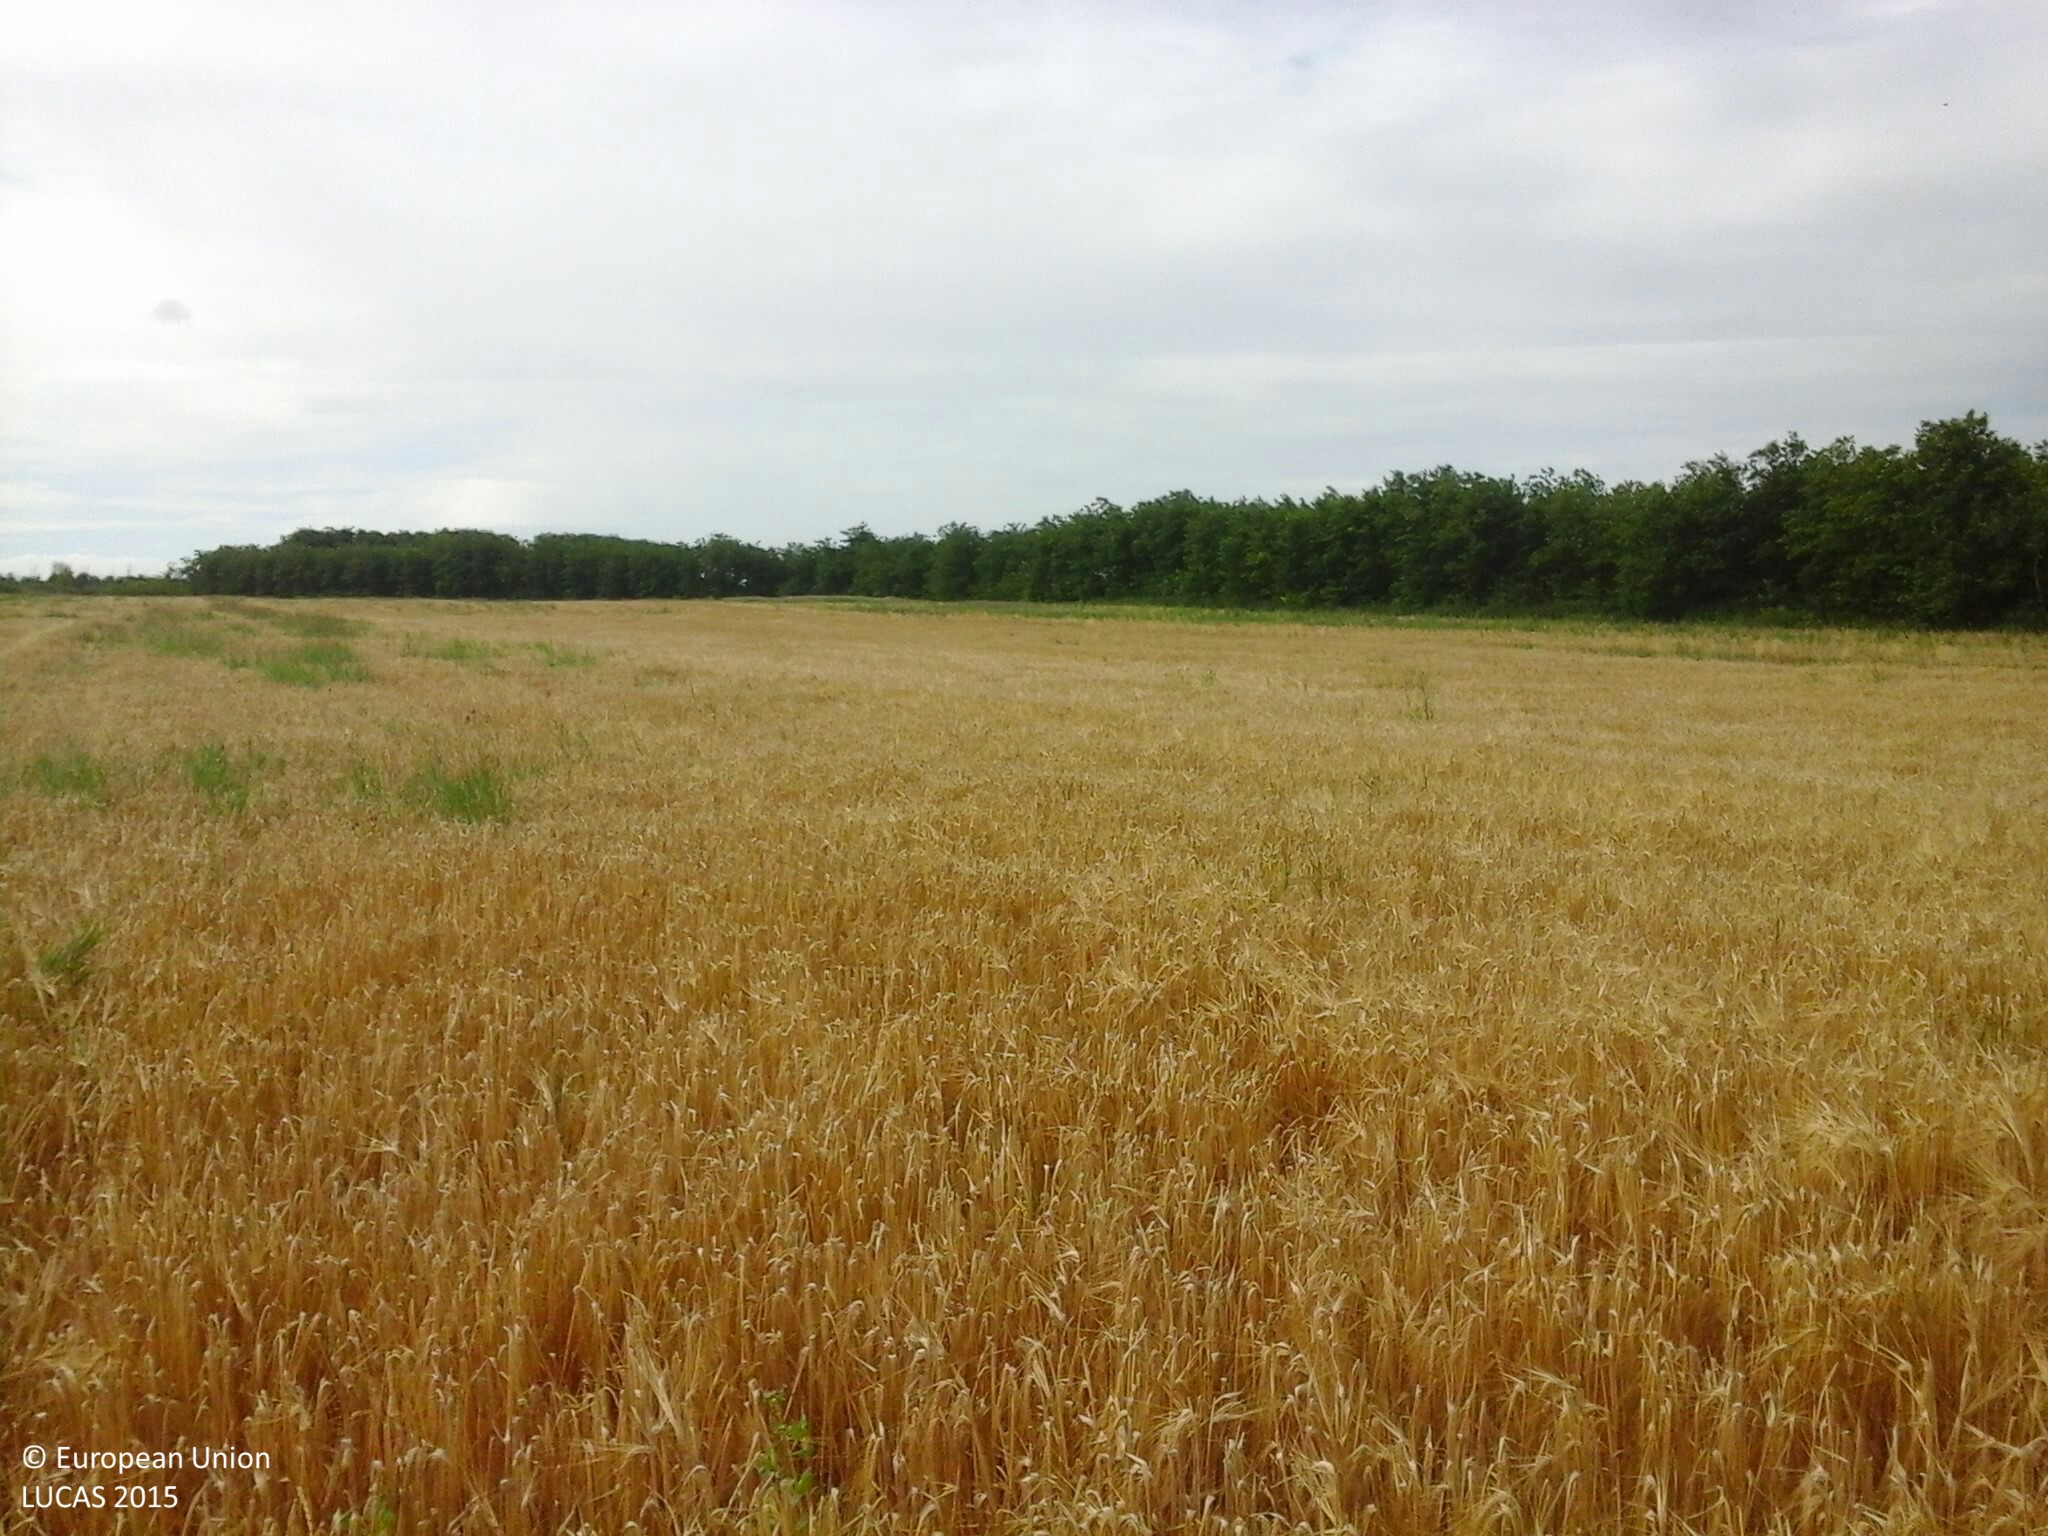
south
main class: Cropland
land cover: Barley
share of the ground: > 75 %
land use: Agriculture (excluding fallow land and kitchen gardens)
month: July
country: HU
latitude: 47.1502
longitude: 17.2991
